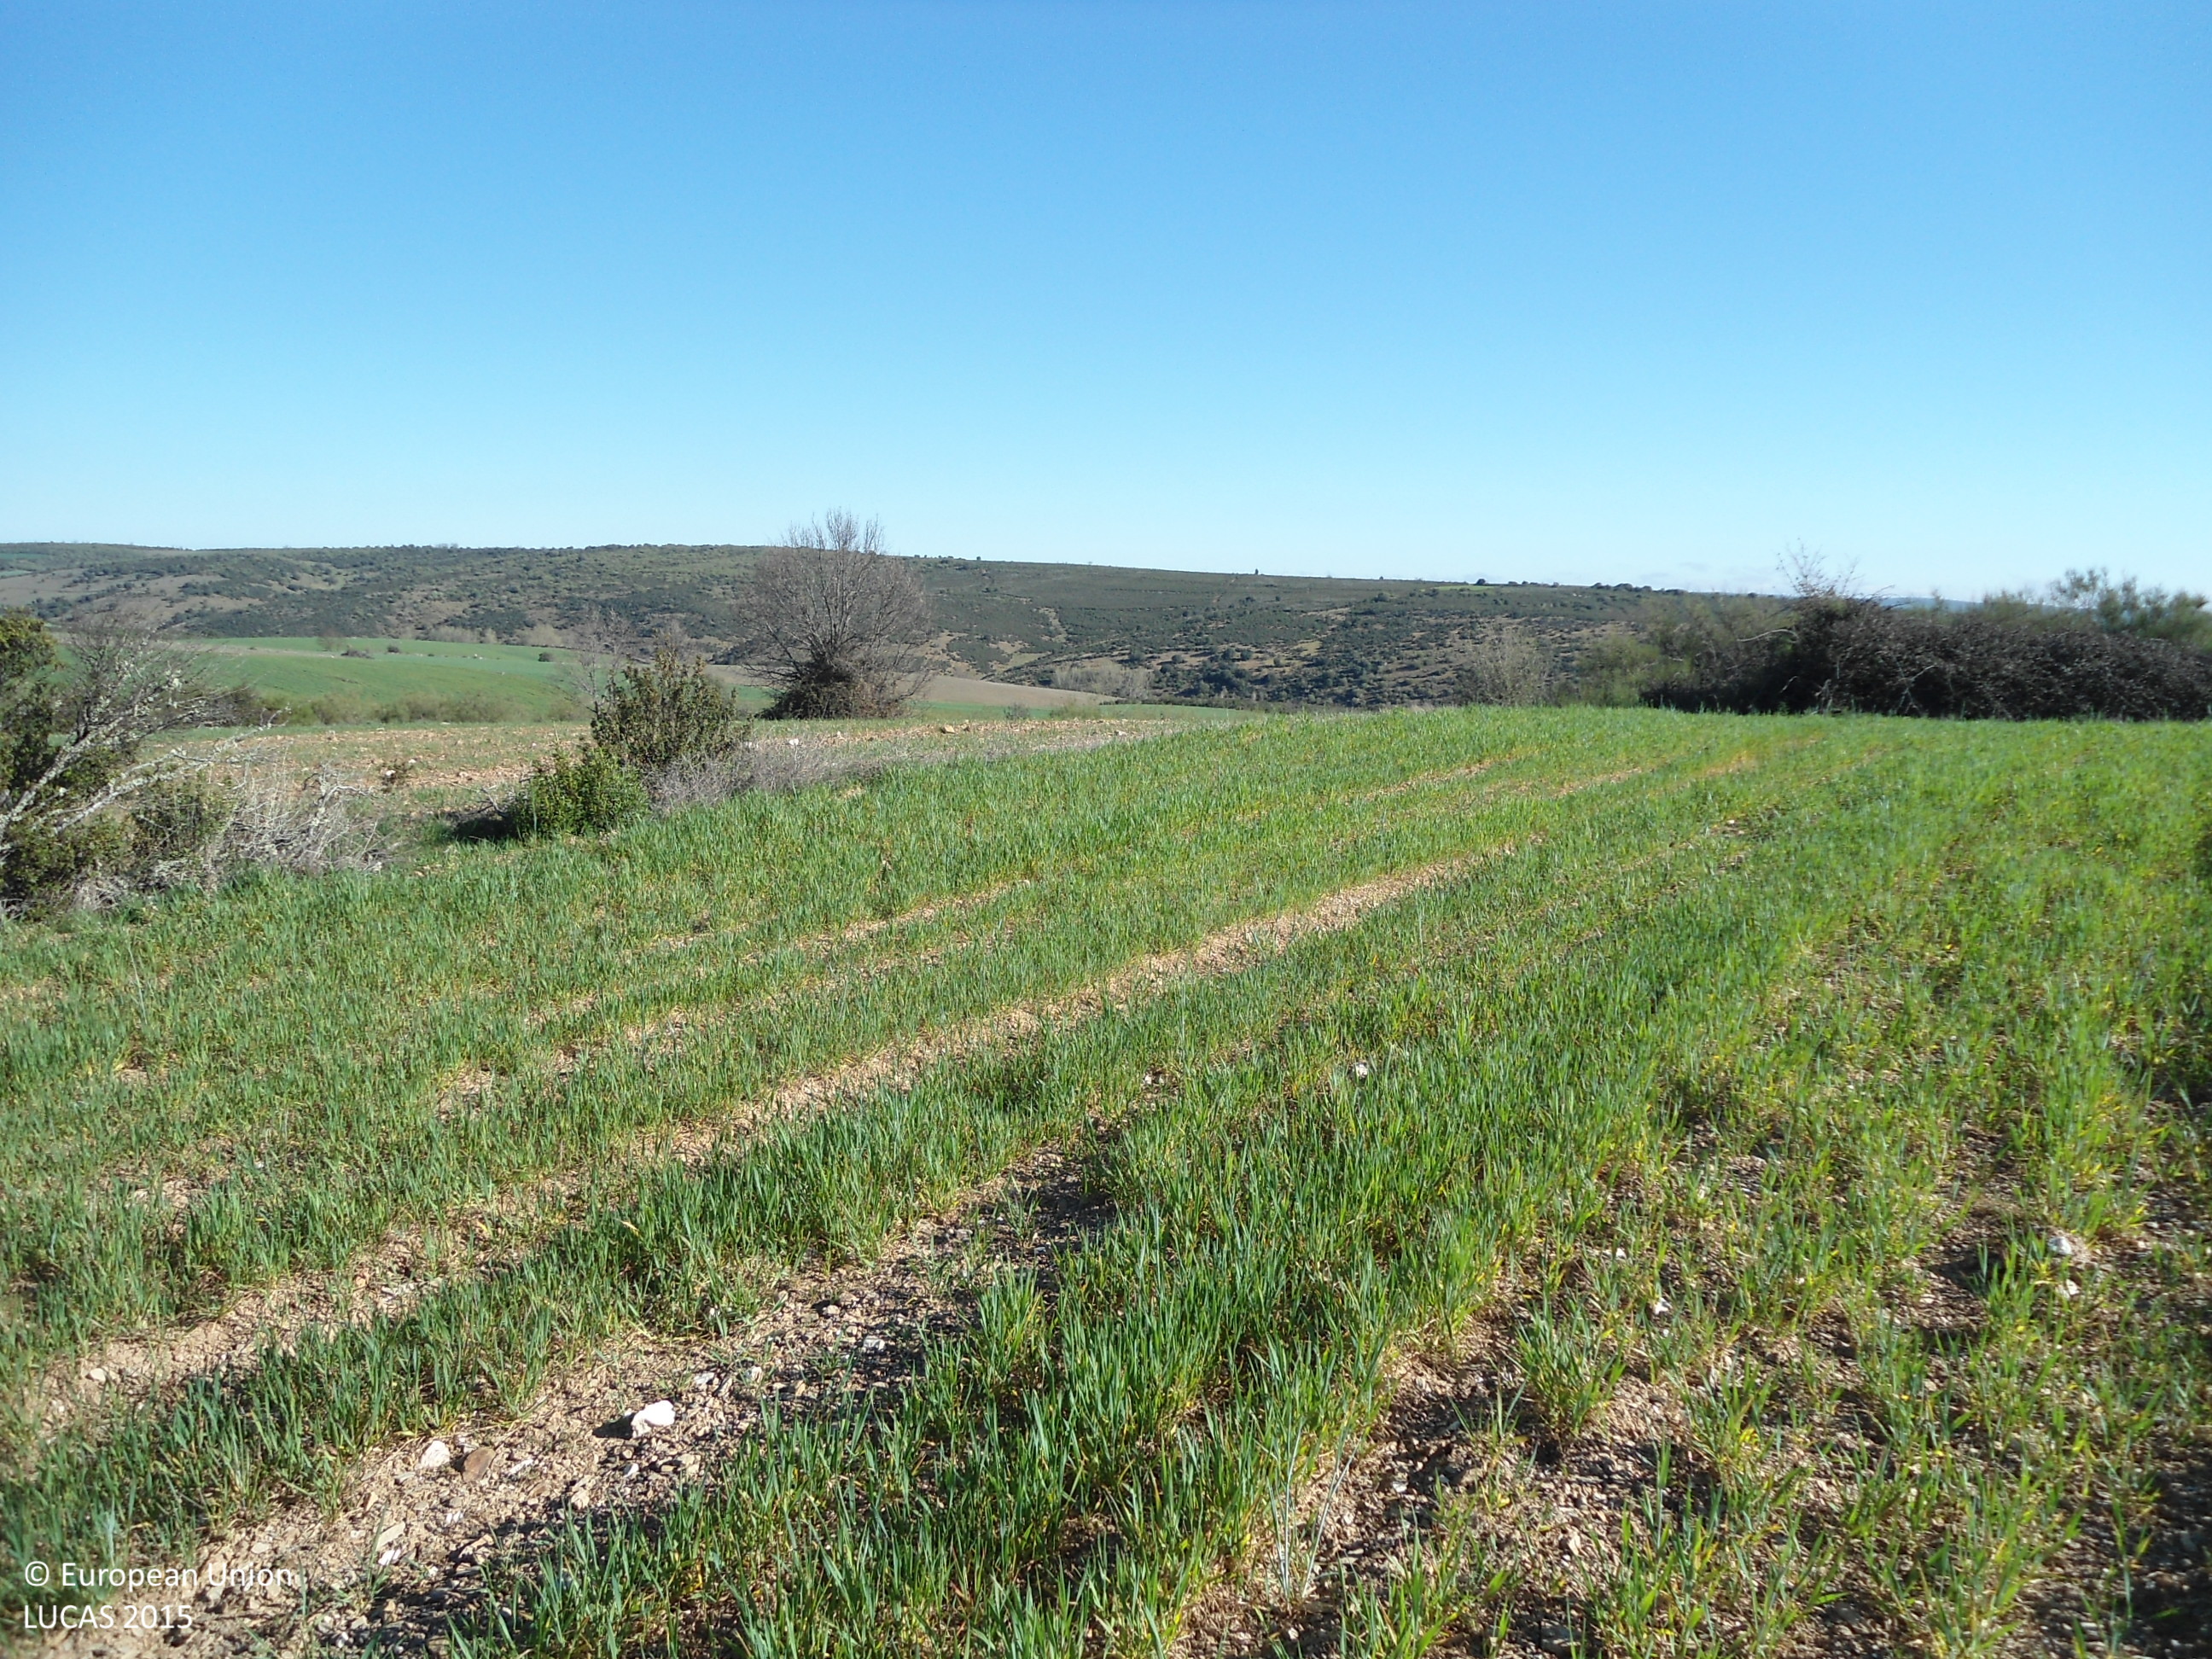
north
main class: Cropland
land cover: Common wheat
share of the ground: > 75 %
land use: Agriculture (excluding fallow land and kitchen gardens)
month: April
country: ES
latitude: 41.6638
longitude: -6.1298
